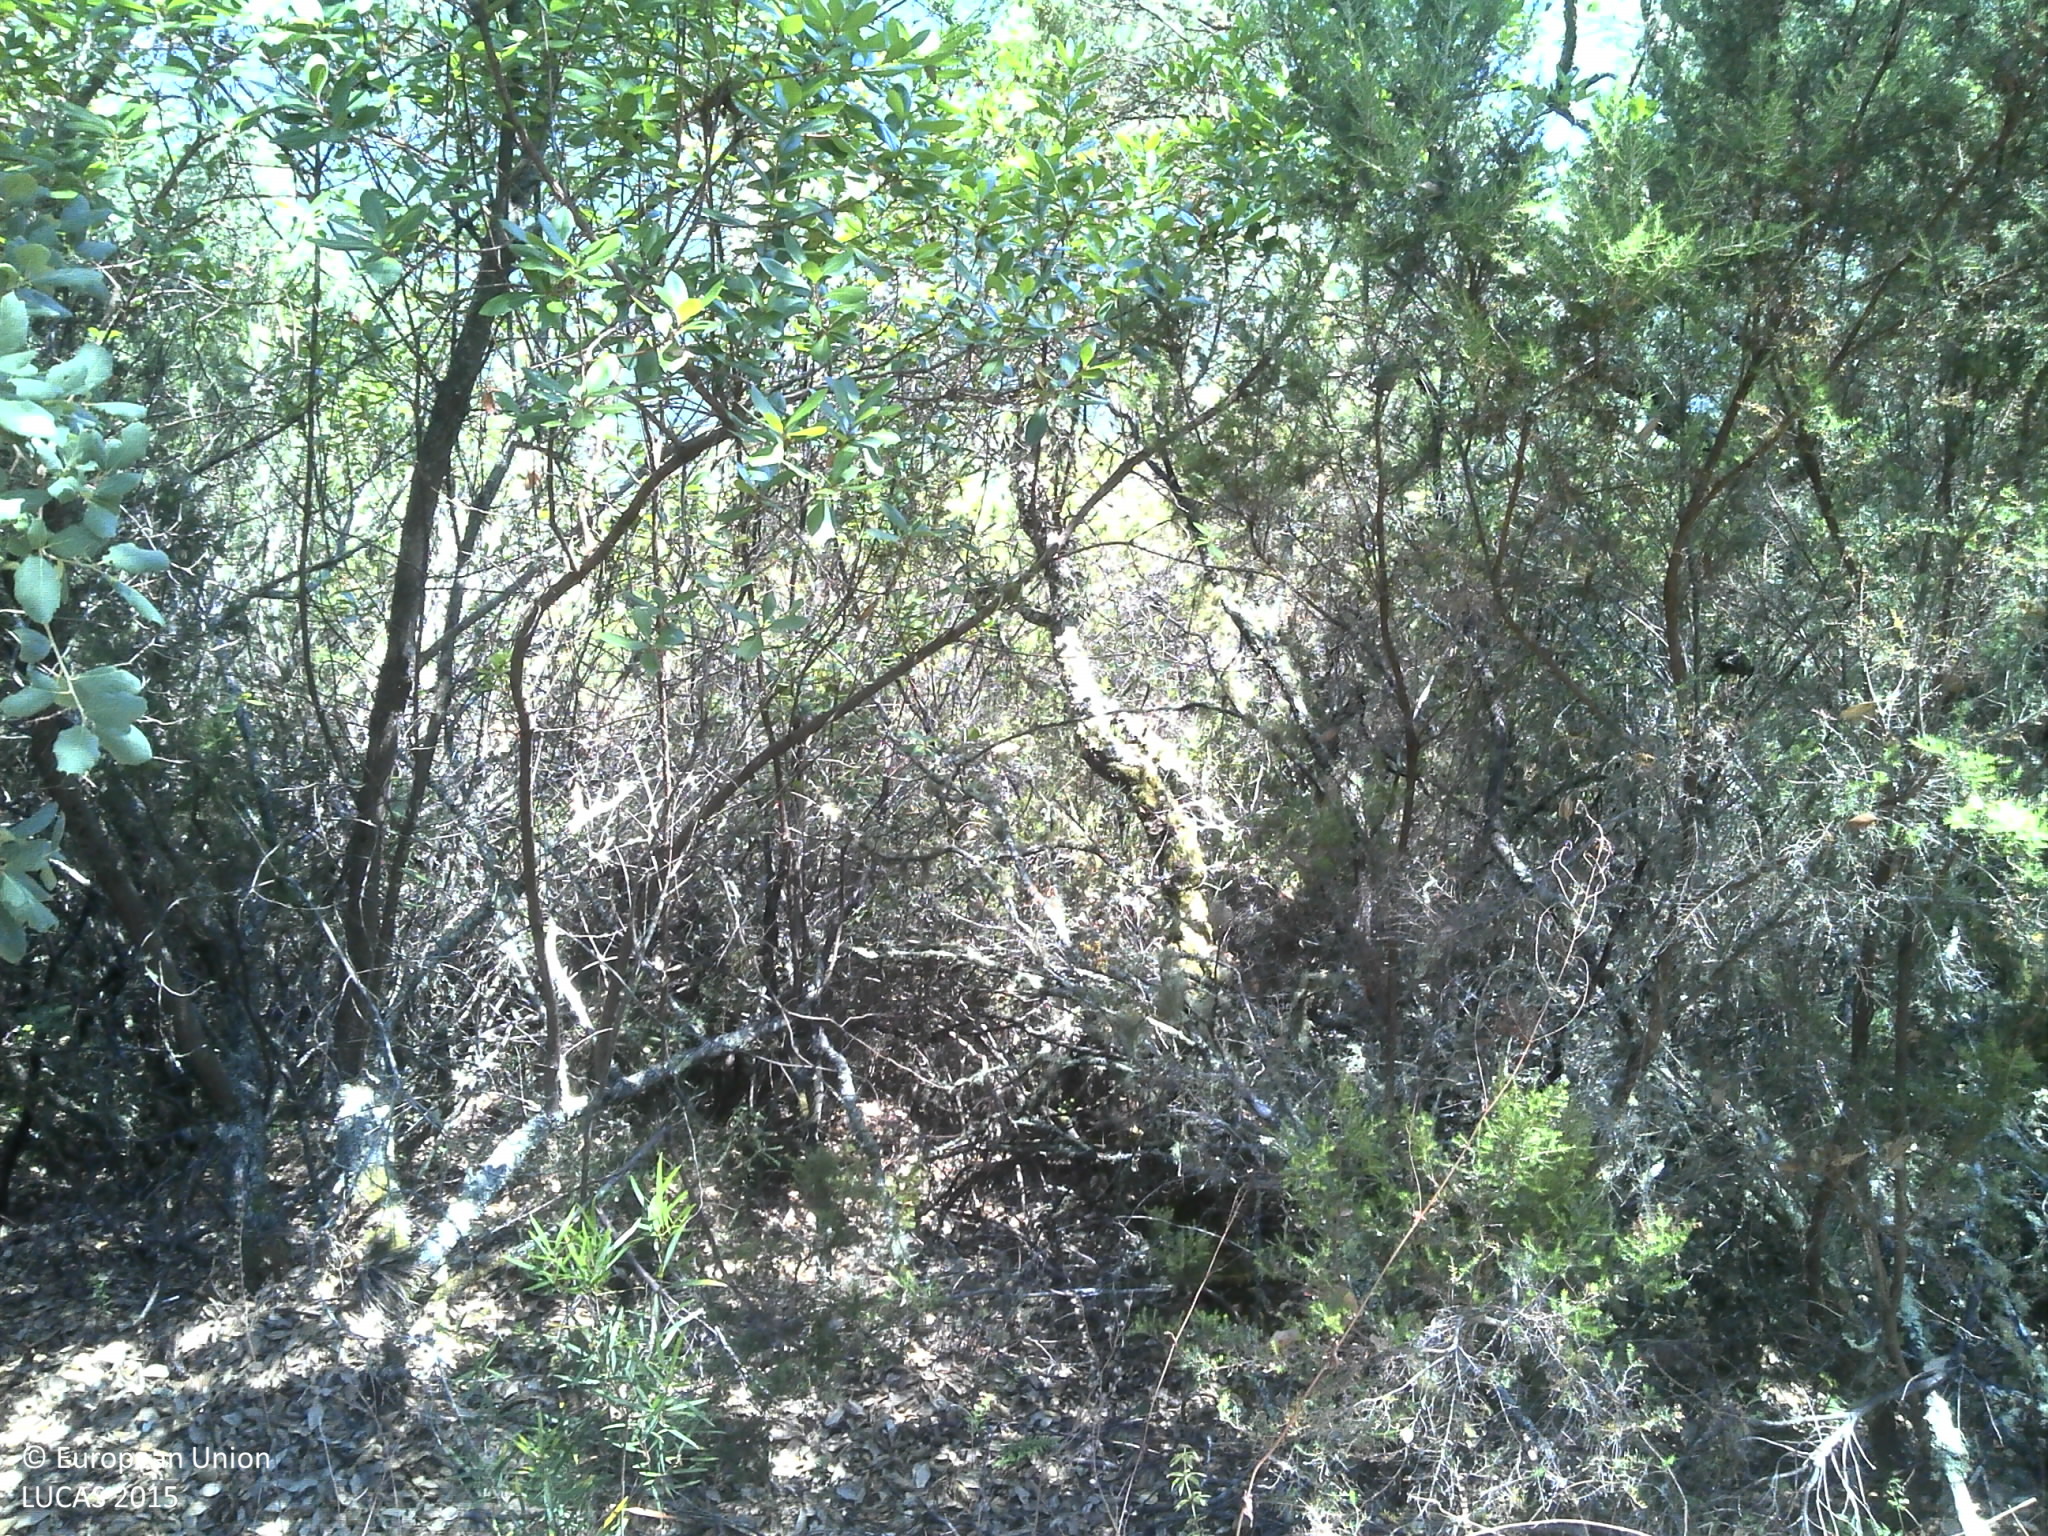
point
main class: Woodland
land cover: Broadleaved woodland
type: broadleaved evergreen forest
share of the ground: 25 - 50 %
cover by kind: broadleaved forest trees 50 %, shrubs 40 %, unconsolidated bare surface 10 %
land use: Semi-natural and natural areas not in use
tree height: > 5 m
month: July
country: PT
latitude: 40.3382
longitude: -8.2200
